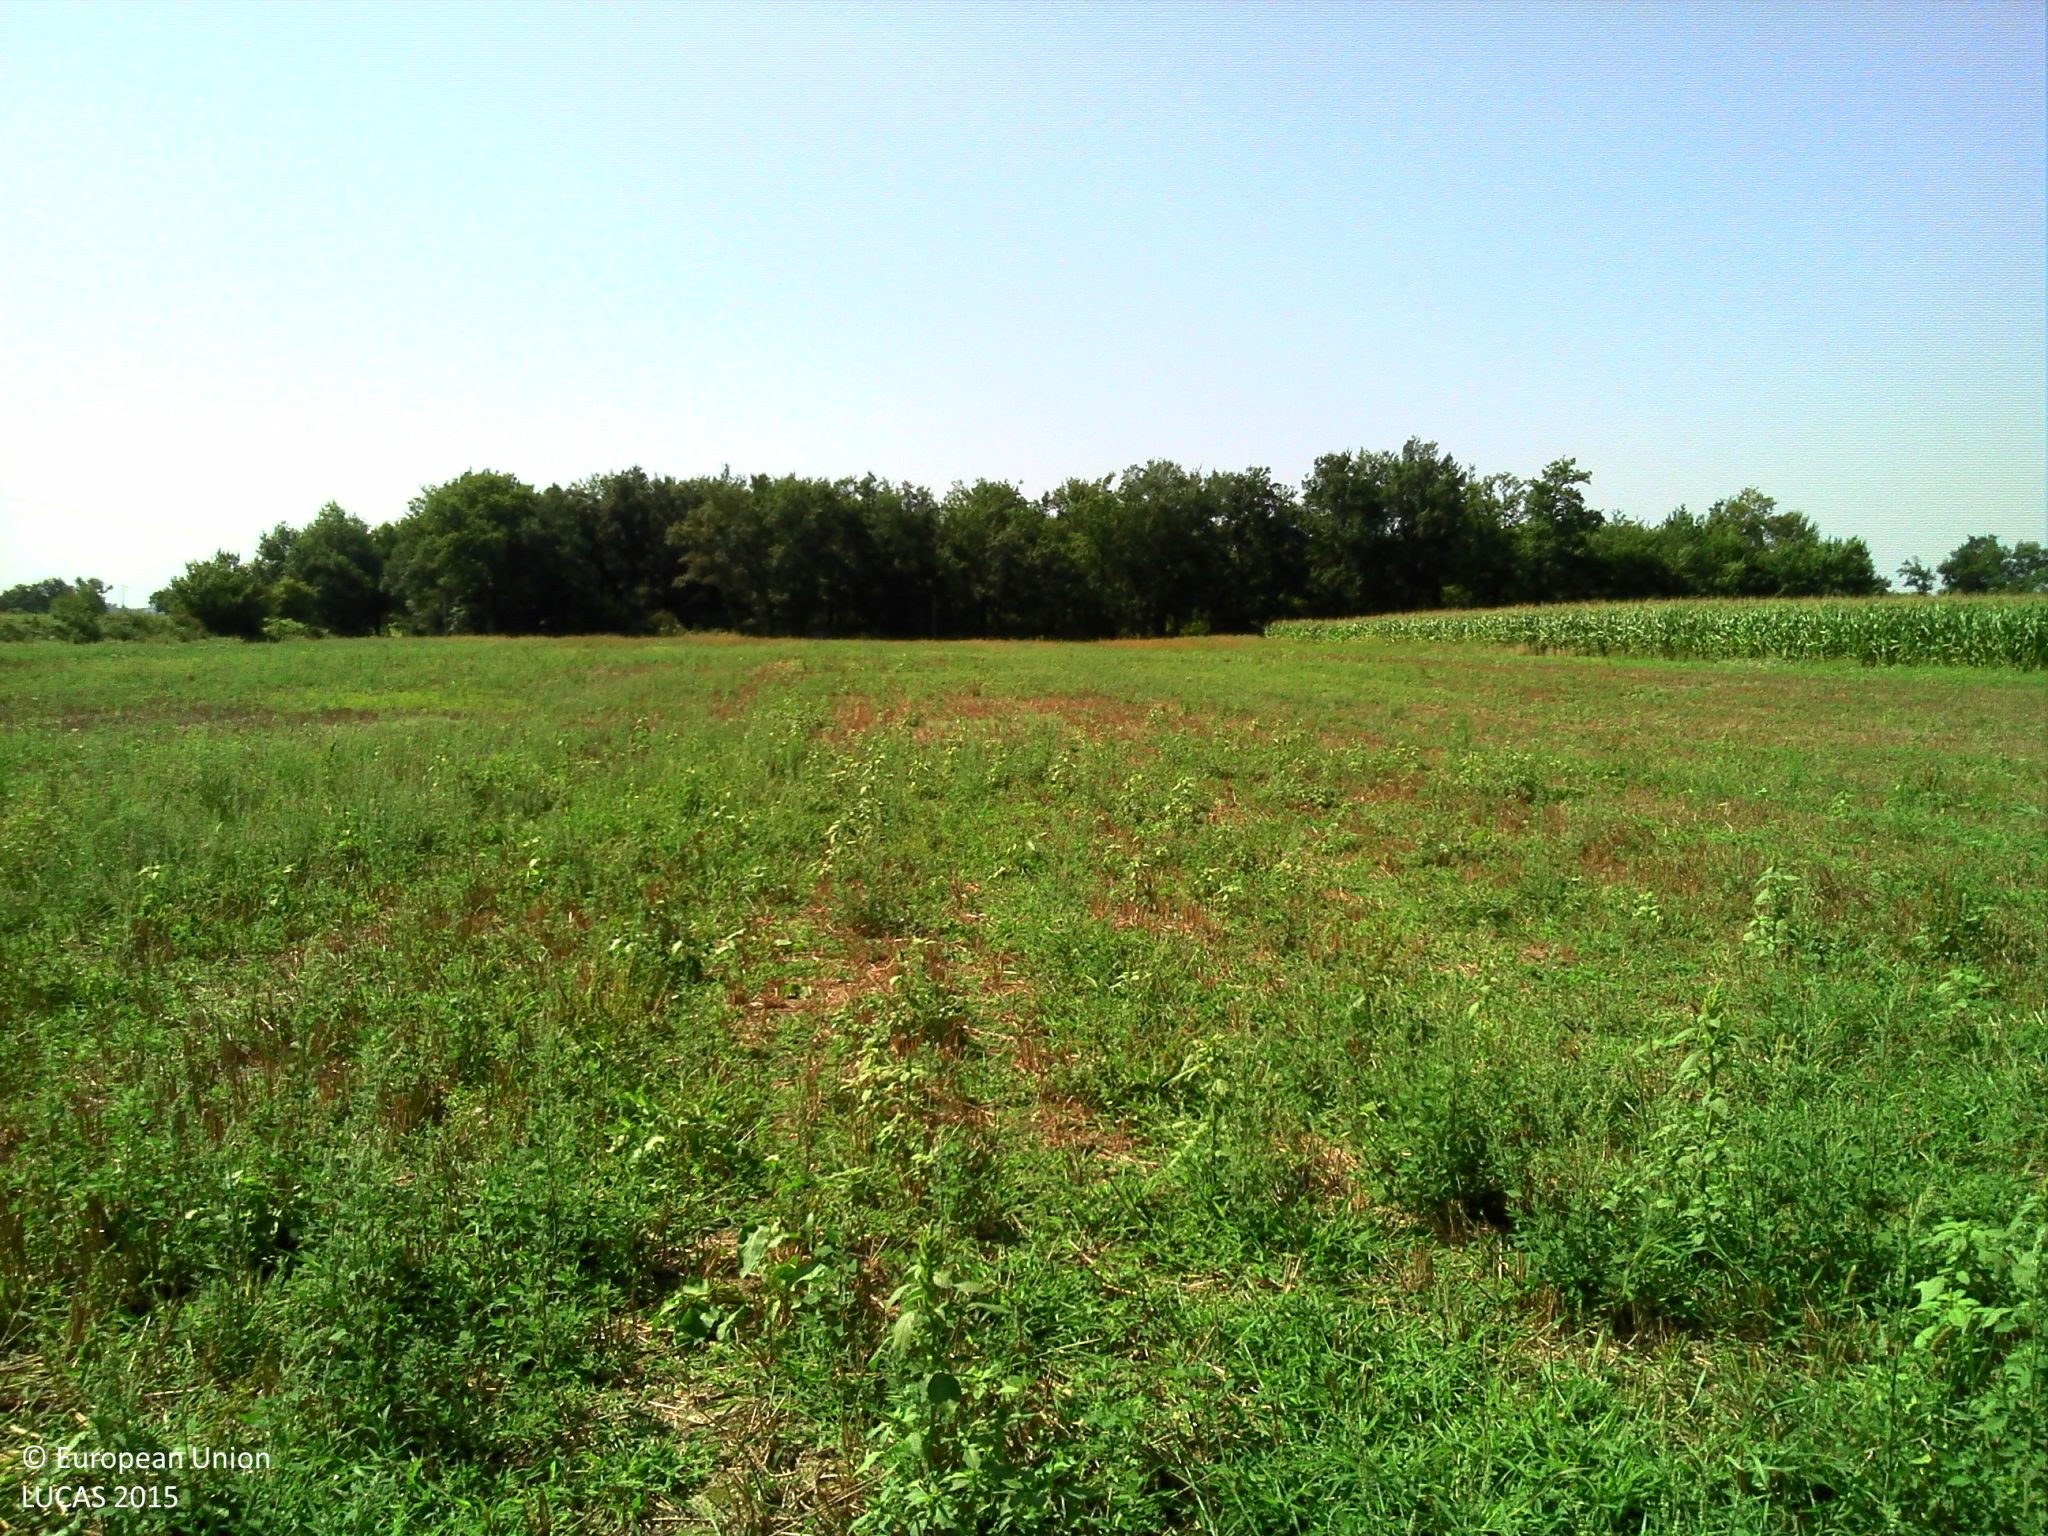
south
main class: Cropland
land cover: Temporary grasslands
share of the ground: > 75 %
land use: Agriculture (excluding fallow land and kitchen gardens)
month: August
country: FR
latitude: 43.7968
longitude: -0.5135
